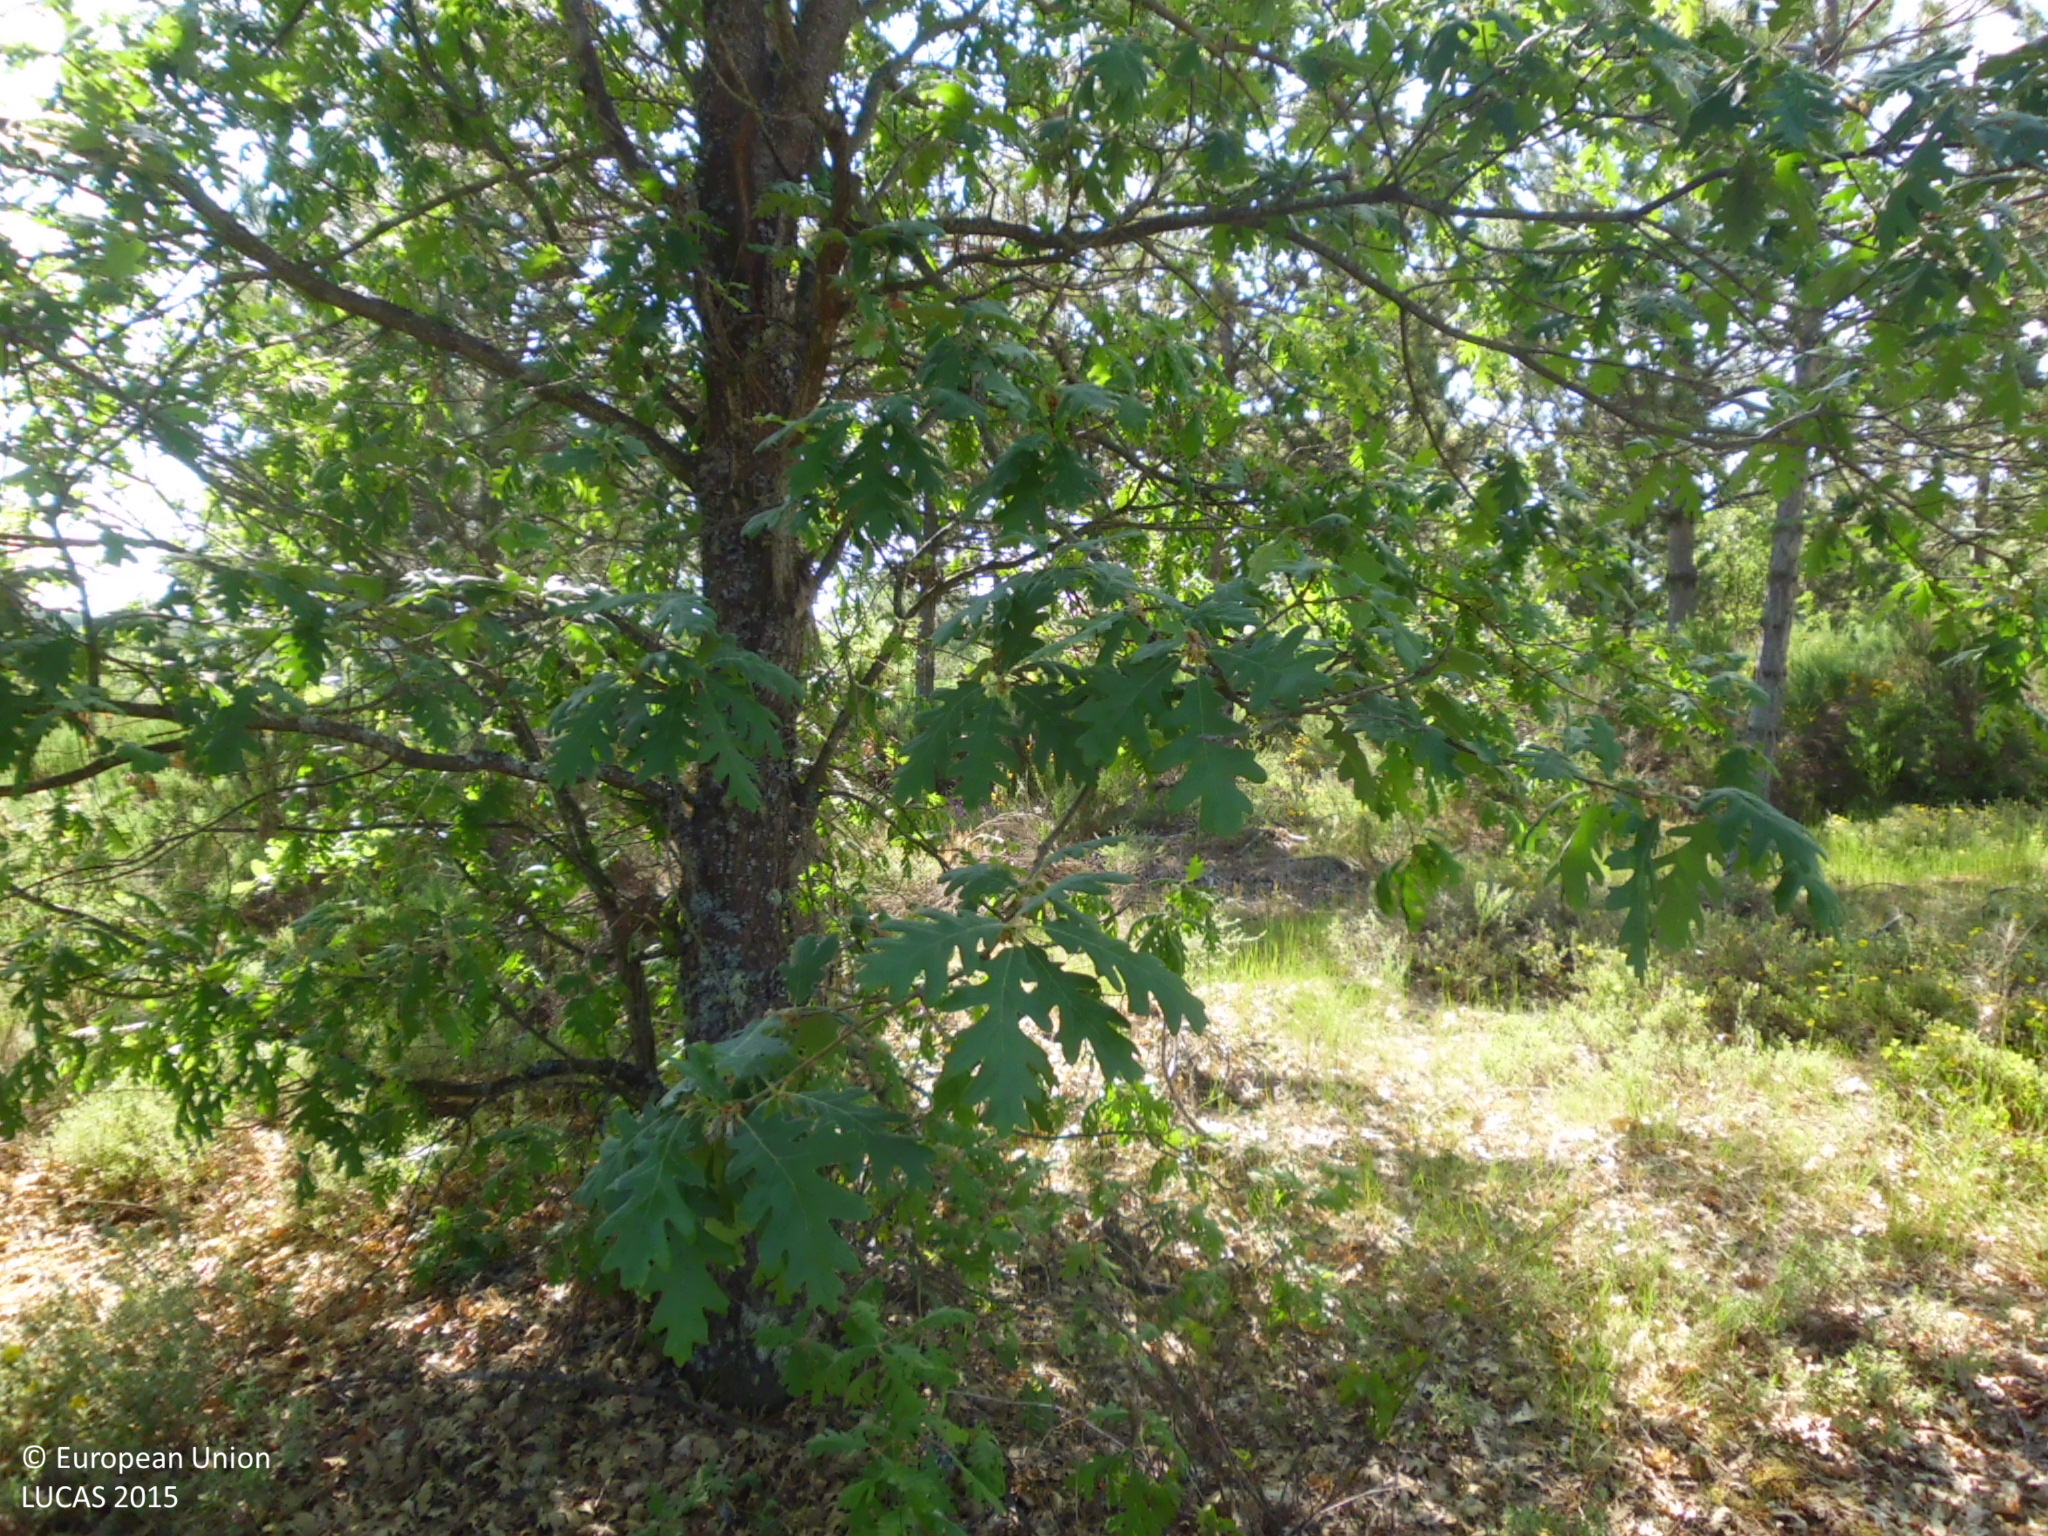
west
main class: Woodland
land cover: Pine dominated mixed woodland
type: coniferous forest of the mediterranean region
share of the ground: 50 - 75 %
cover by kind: coniferous forest trees 45 %, broadleaved forest trees 25 %, herbaceous plants 20 %, shrubs 10 %
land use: Forestry
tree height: > 5 m
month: May
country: ES
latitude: 42.7129
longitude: -5.4190
